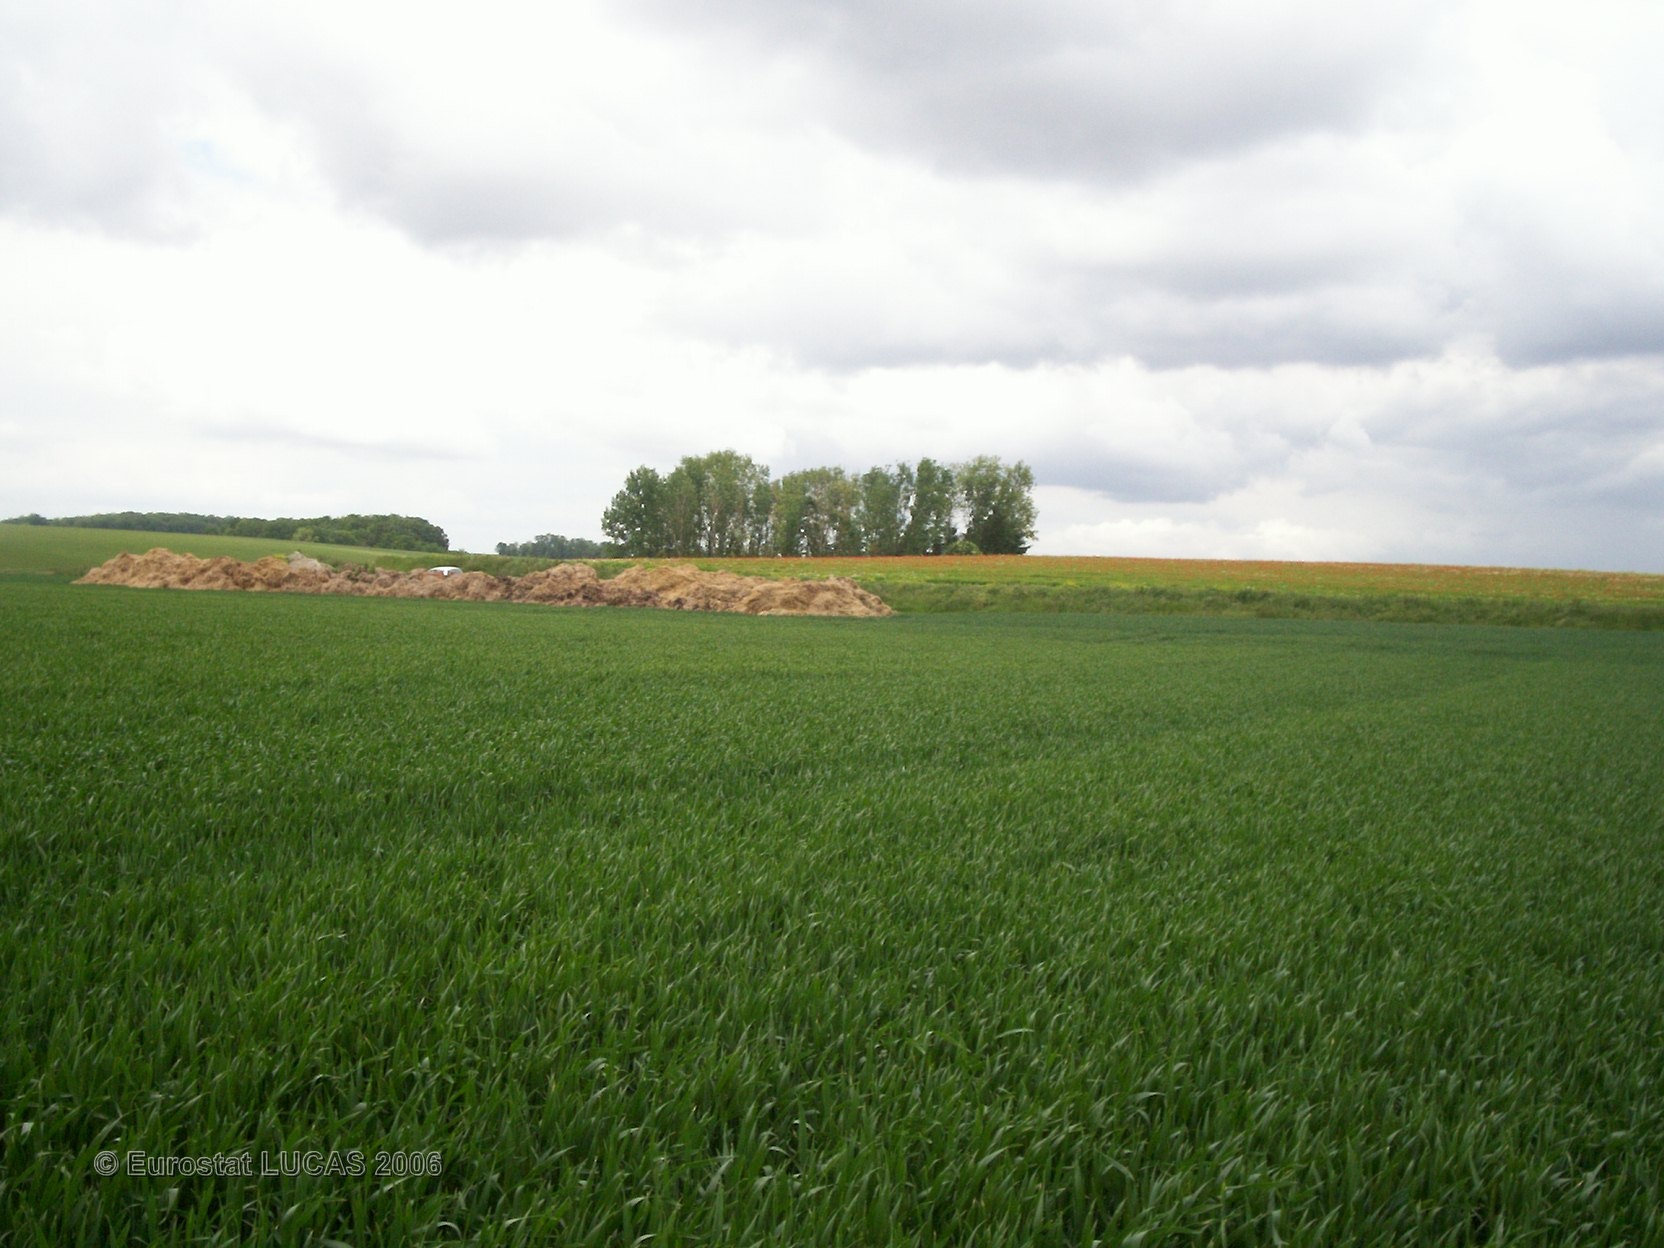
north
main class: Cropland
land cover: Common wheat
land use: Agriculture (excluding fallow land and kitchen gardens)
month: May
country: FR
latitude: 49.7820
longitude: 2.6137
